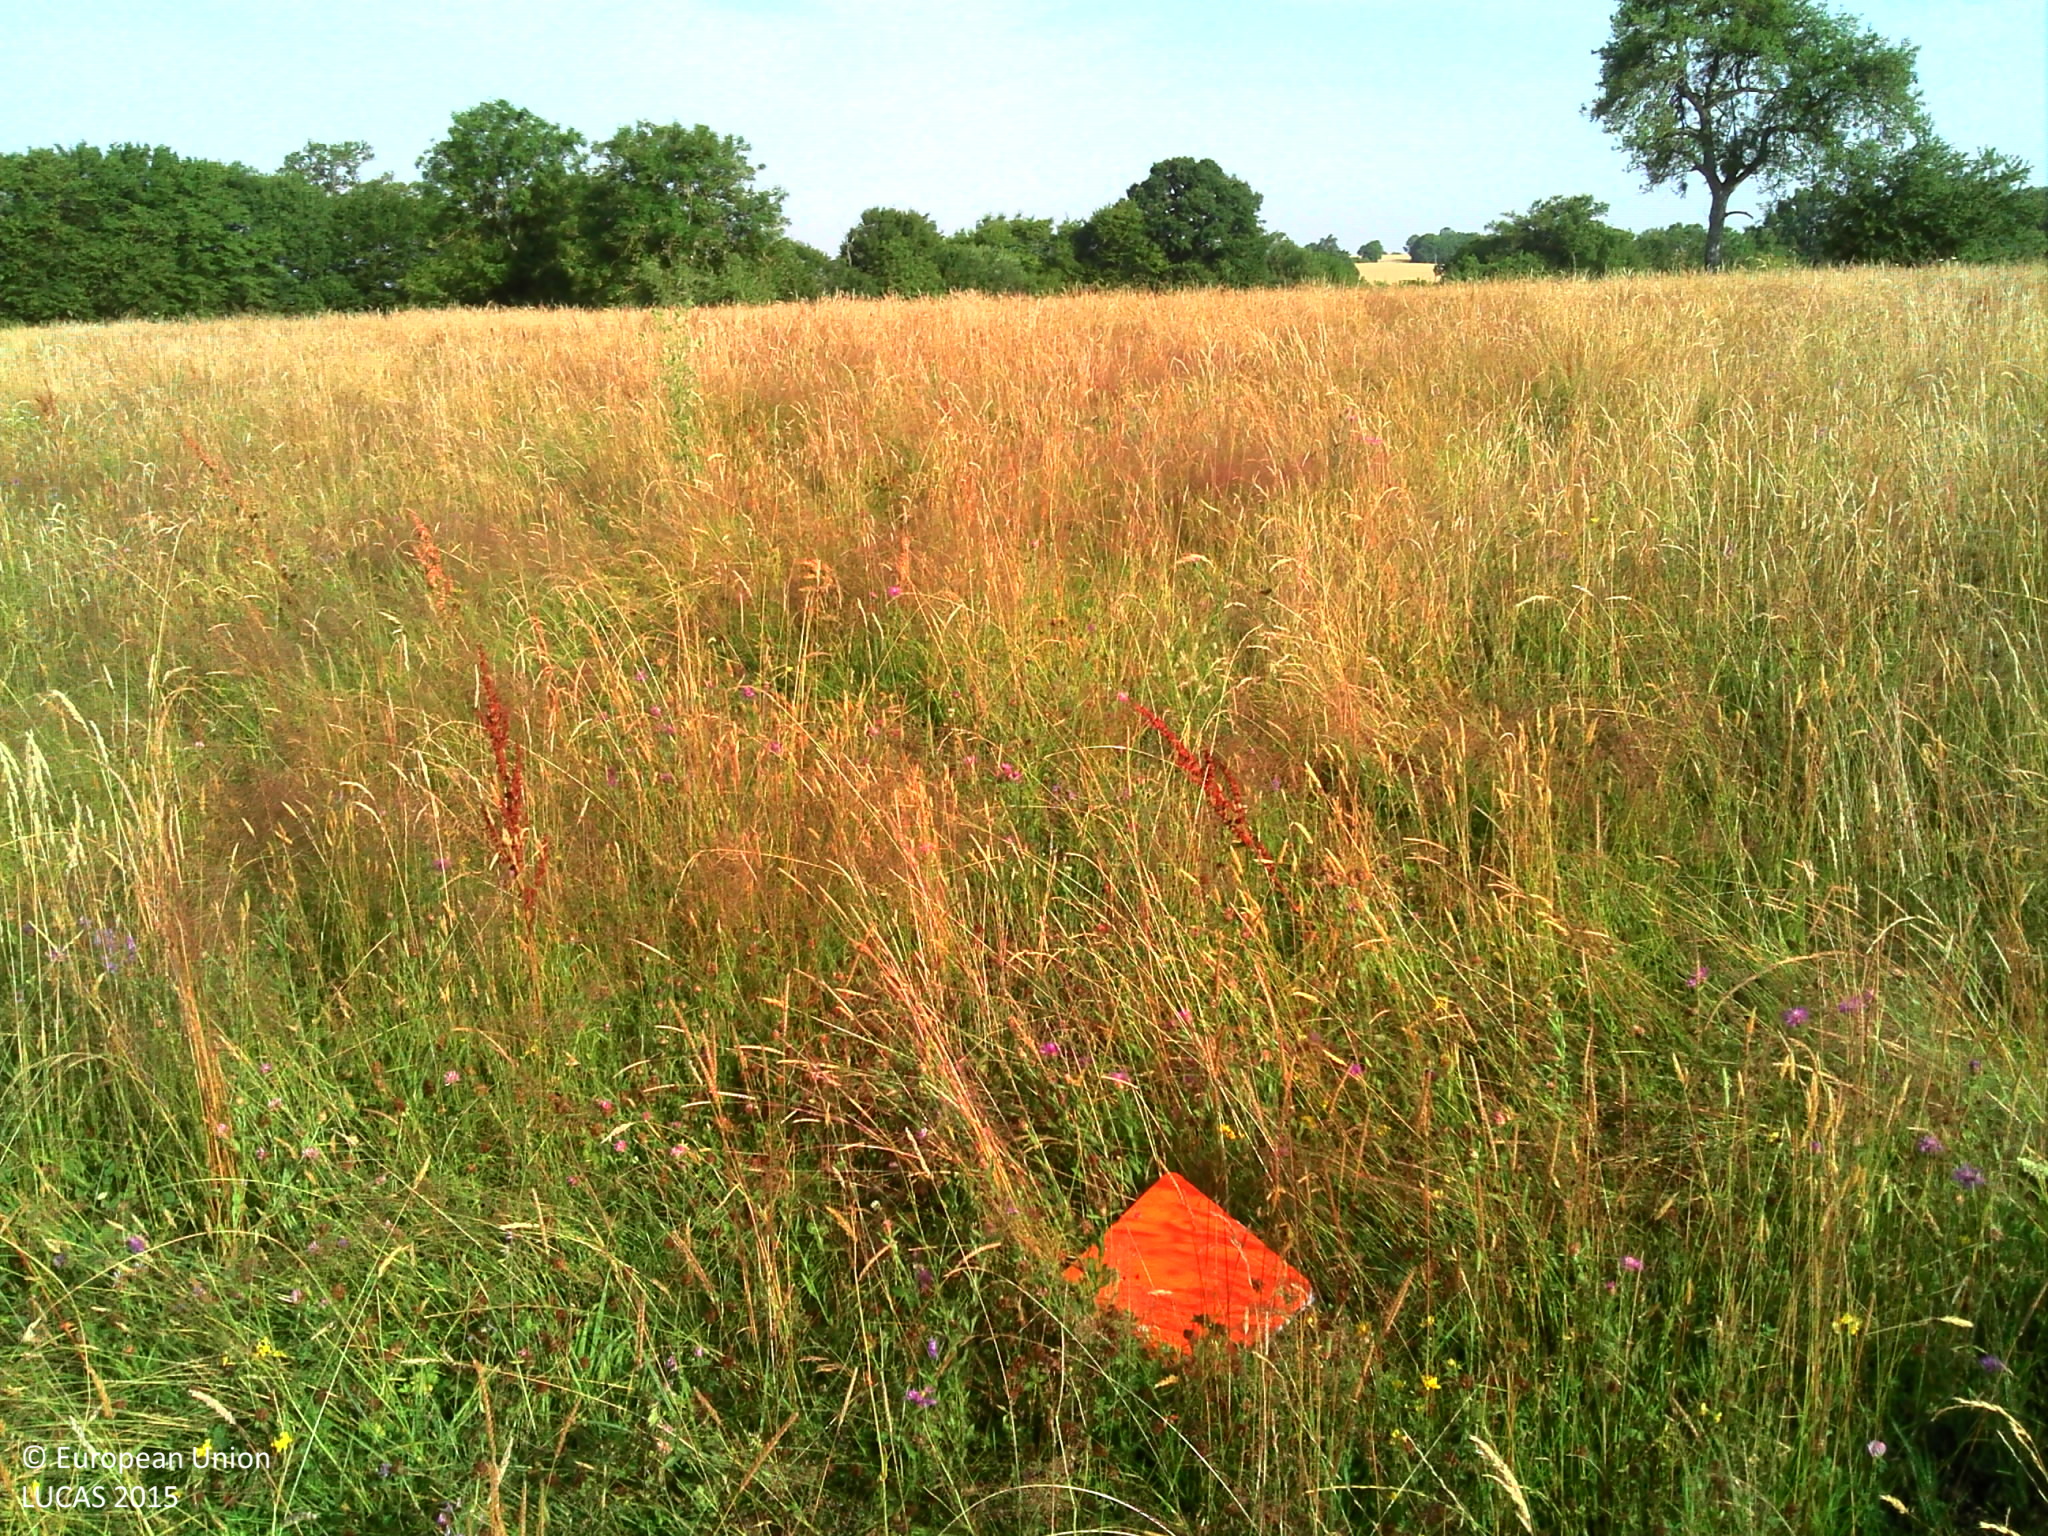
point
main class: Grassland
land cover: Grassland without tree/shrub cover
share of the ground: > 75 %
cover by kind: herbaceous plants 100 %
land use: Agriculture (excluding fallow land and kitchen gardens)
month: July
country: FR
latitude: 47.1873
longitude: 3.5702
